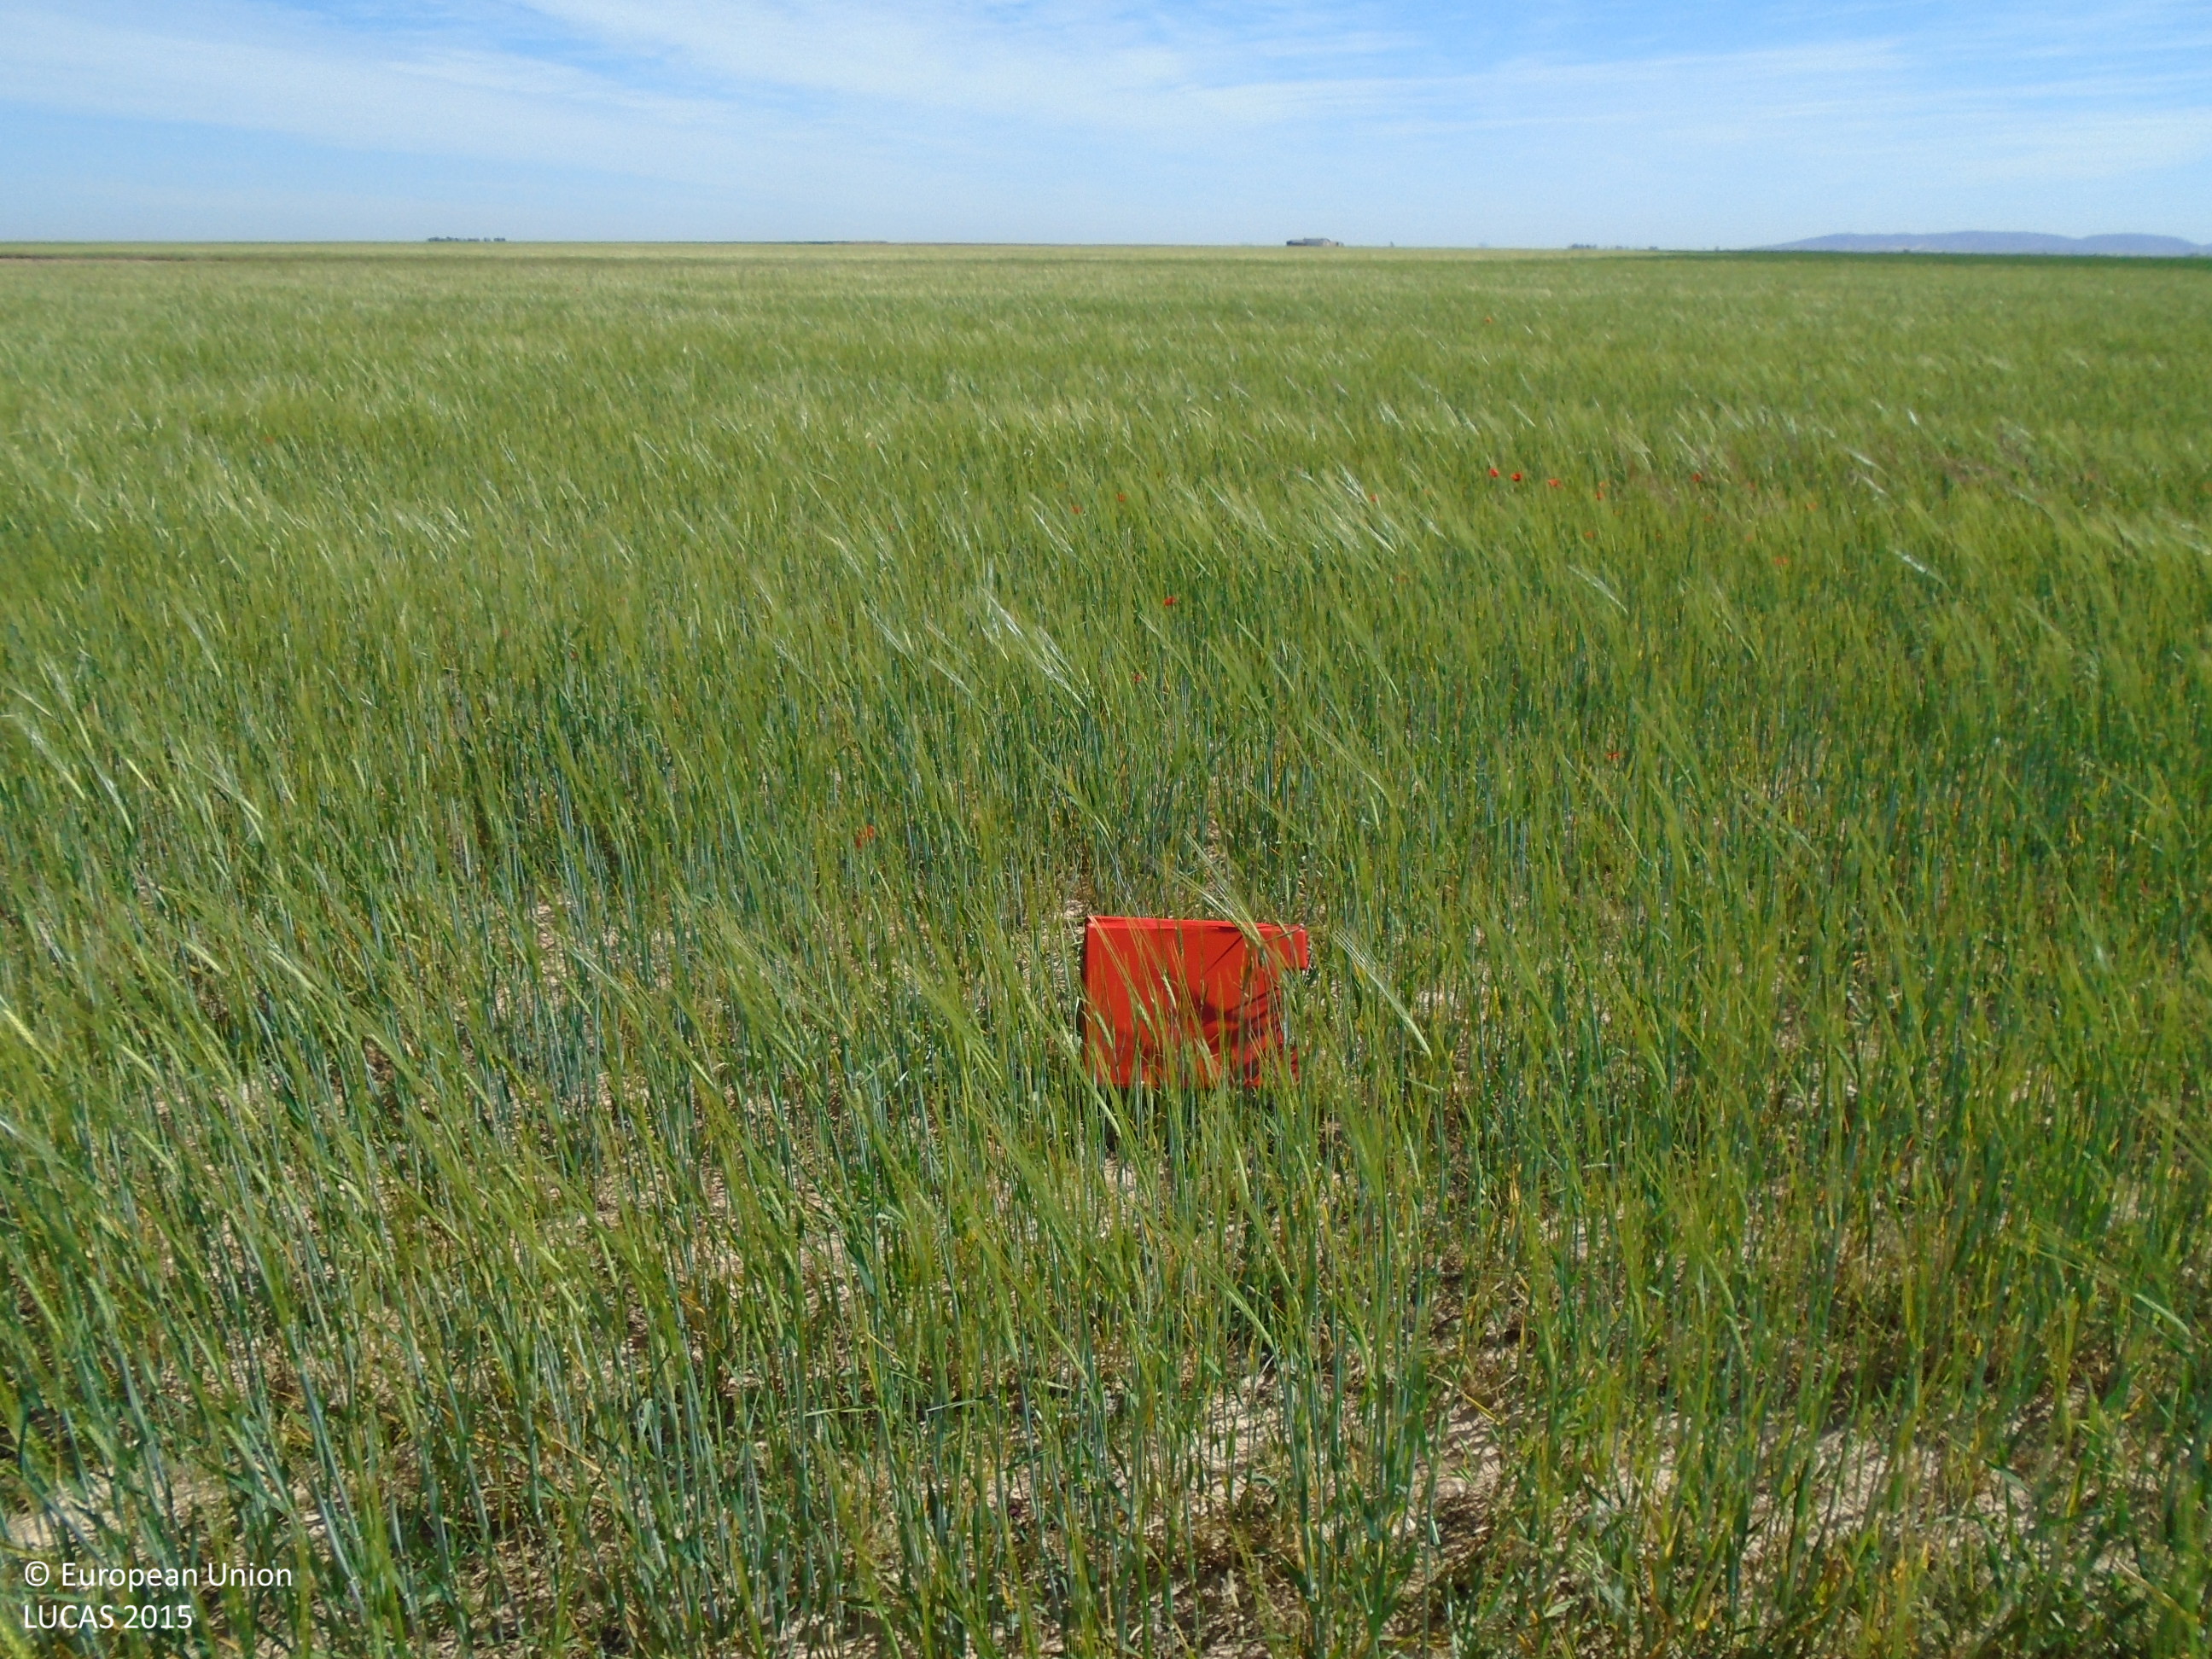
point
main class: Cropland
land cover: Barley
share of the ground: > 75 %
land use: Agriculture (excluding fallow land and kitchen gardens)
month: May
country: ES
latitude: 39.6304
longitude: -3.5752
